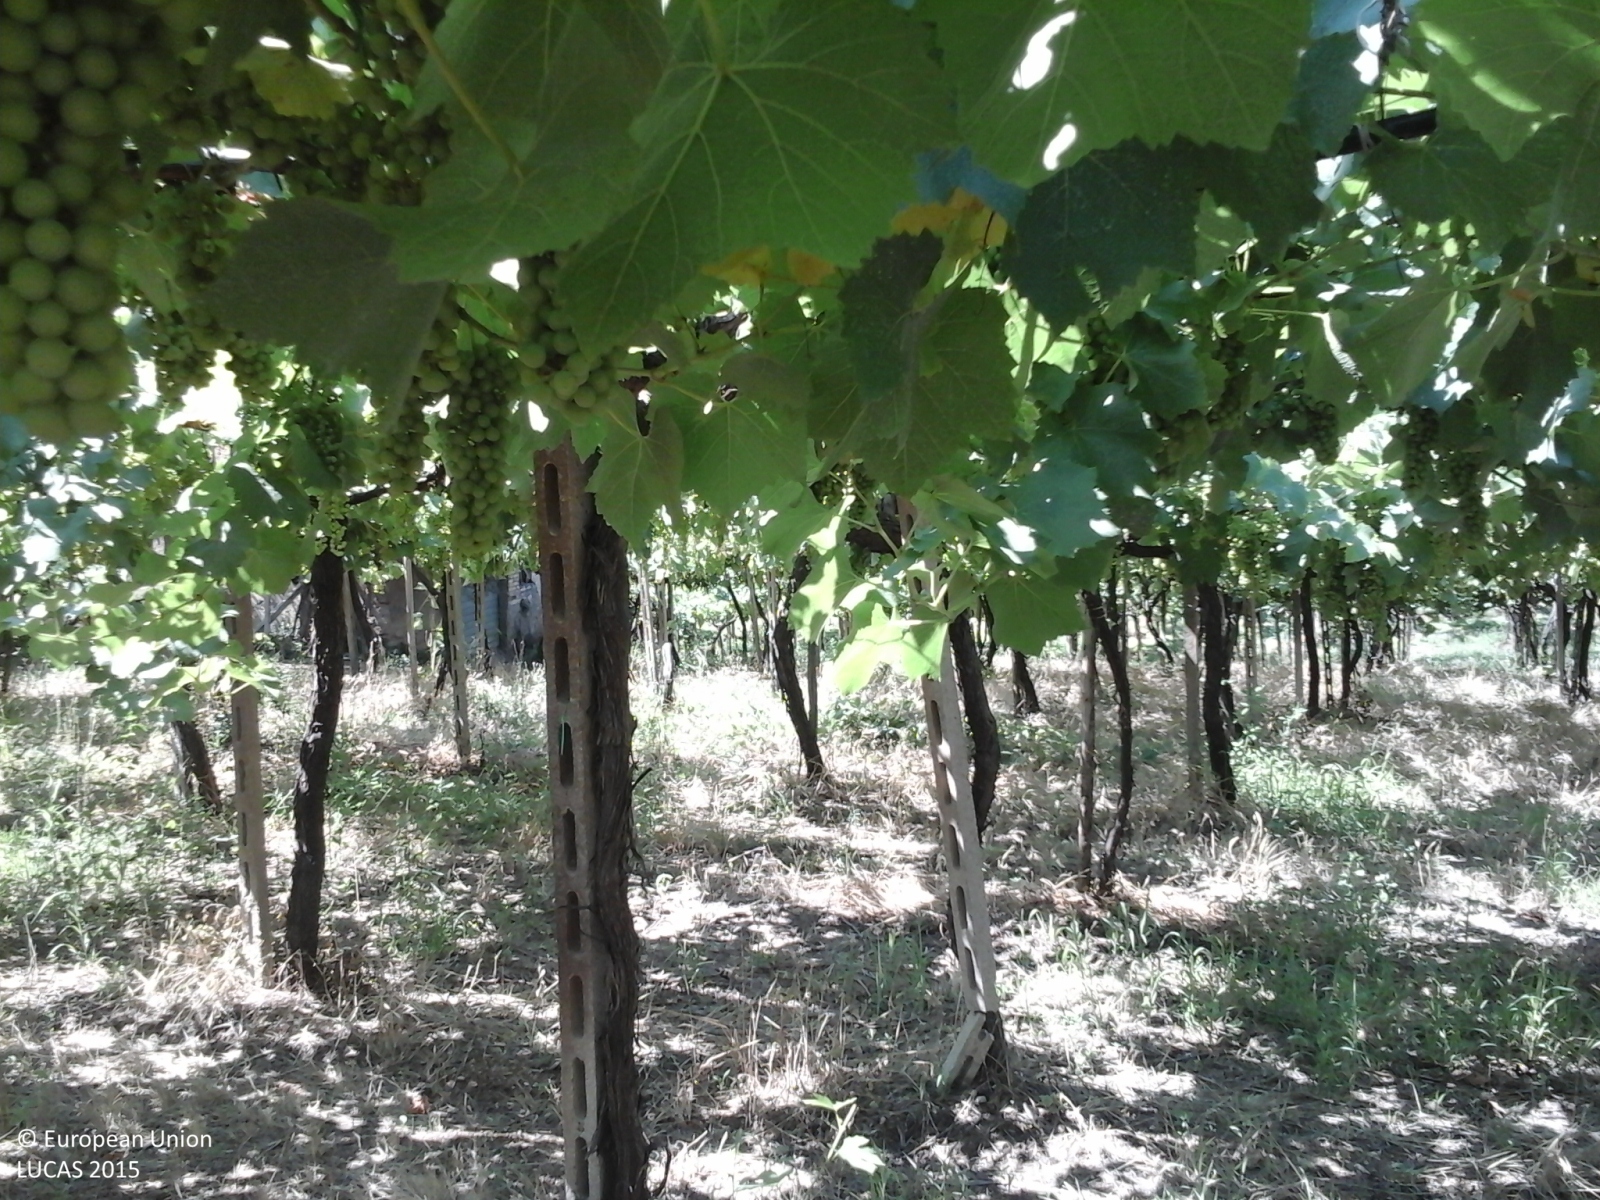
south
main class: Cropland
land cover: Vineyards
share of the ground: 25 - 50 %
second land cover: Spontaneously vegetated surfaces
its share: 25 - 50 %
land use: Agriculture (excluding fallow land and kitchen gardens)
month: July
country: IT
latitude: 42.2886
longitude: 14.3649
